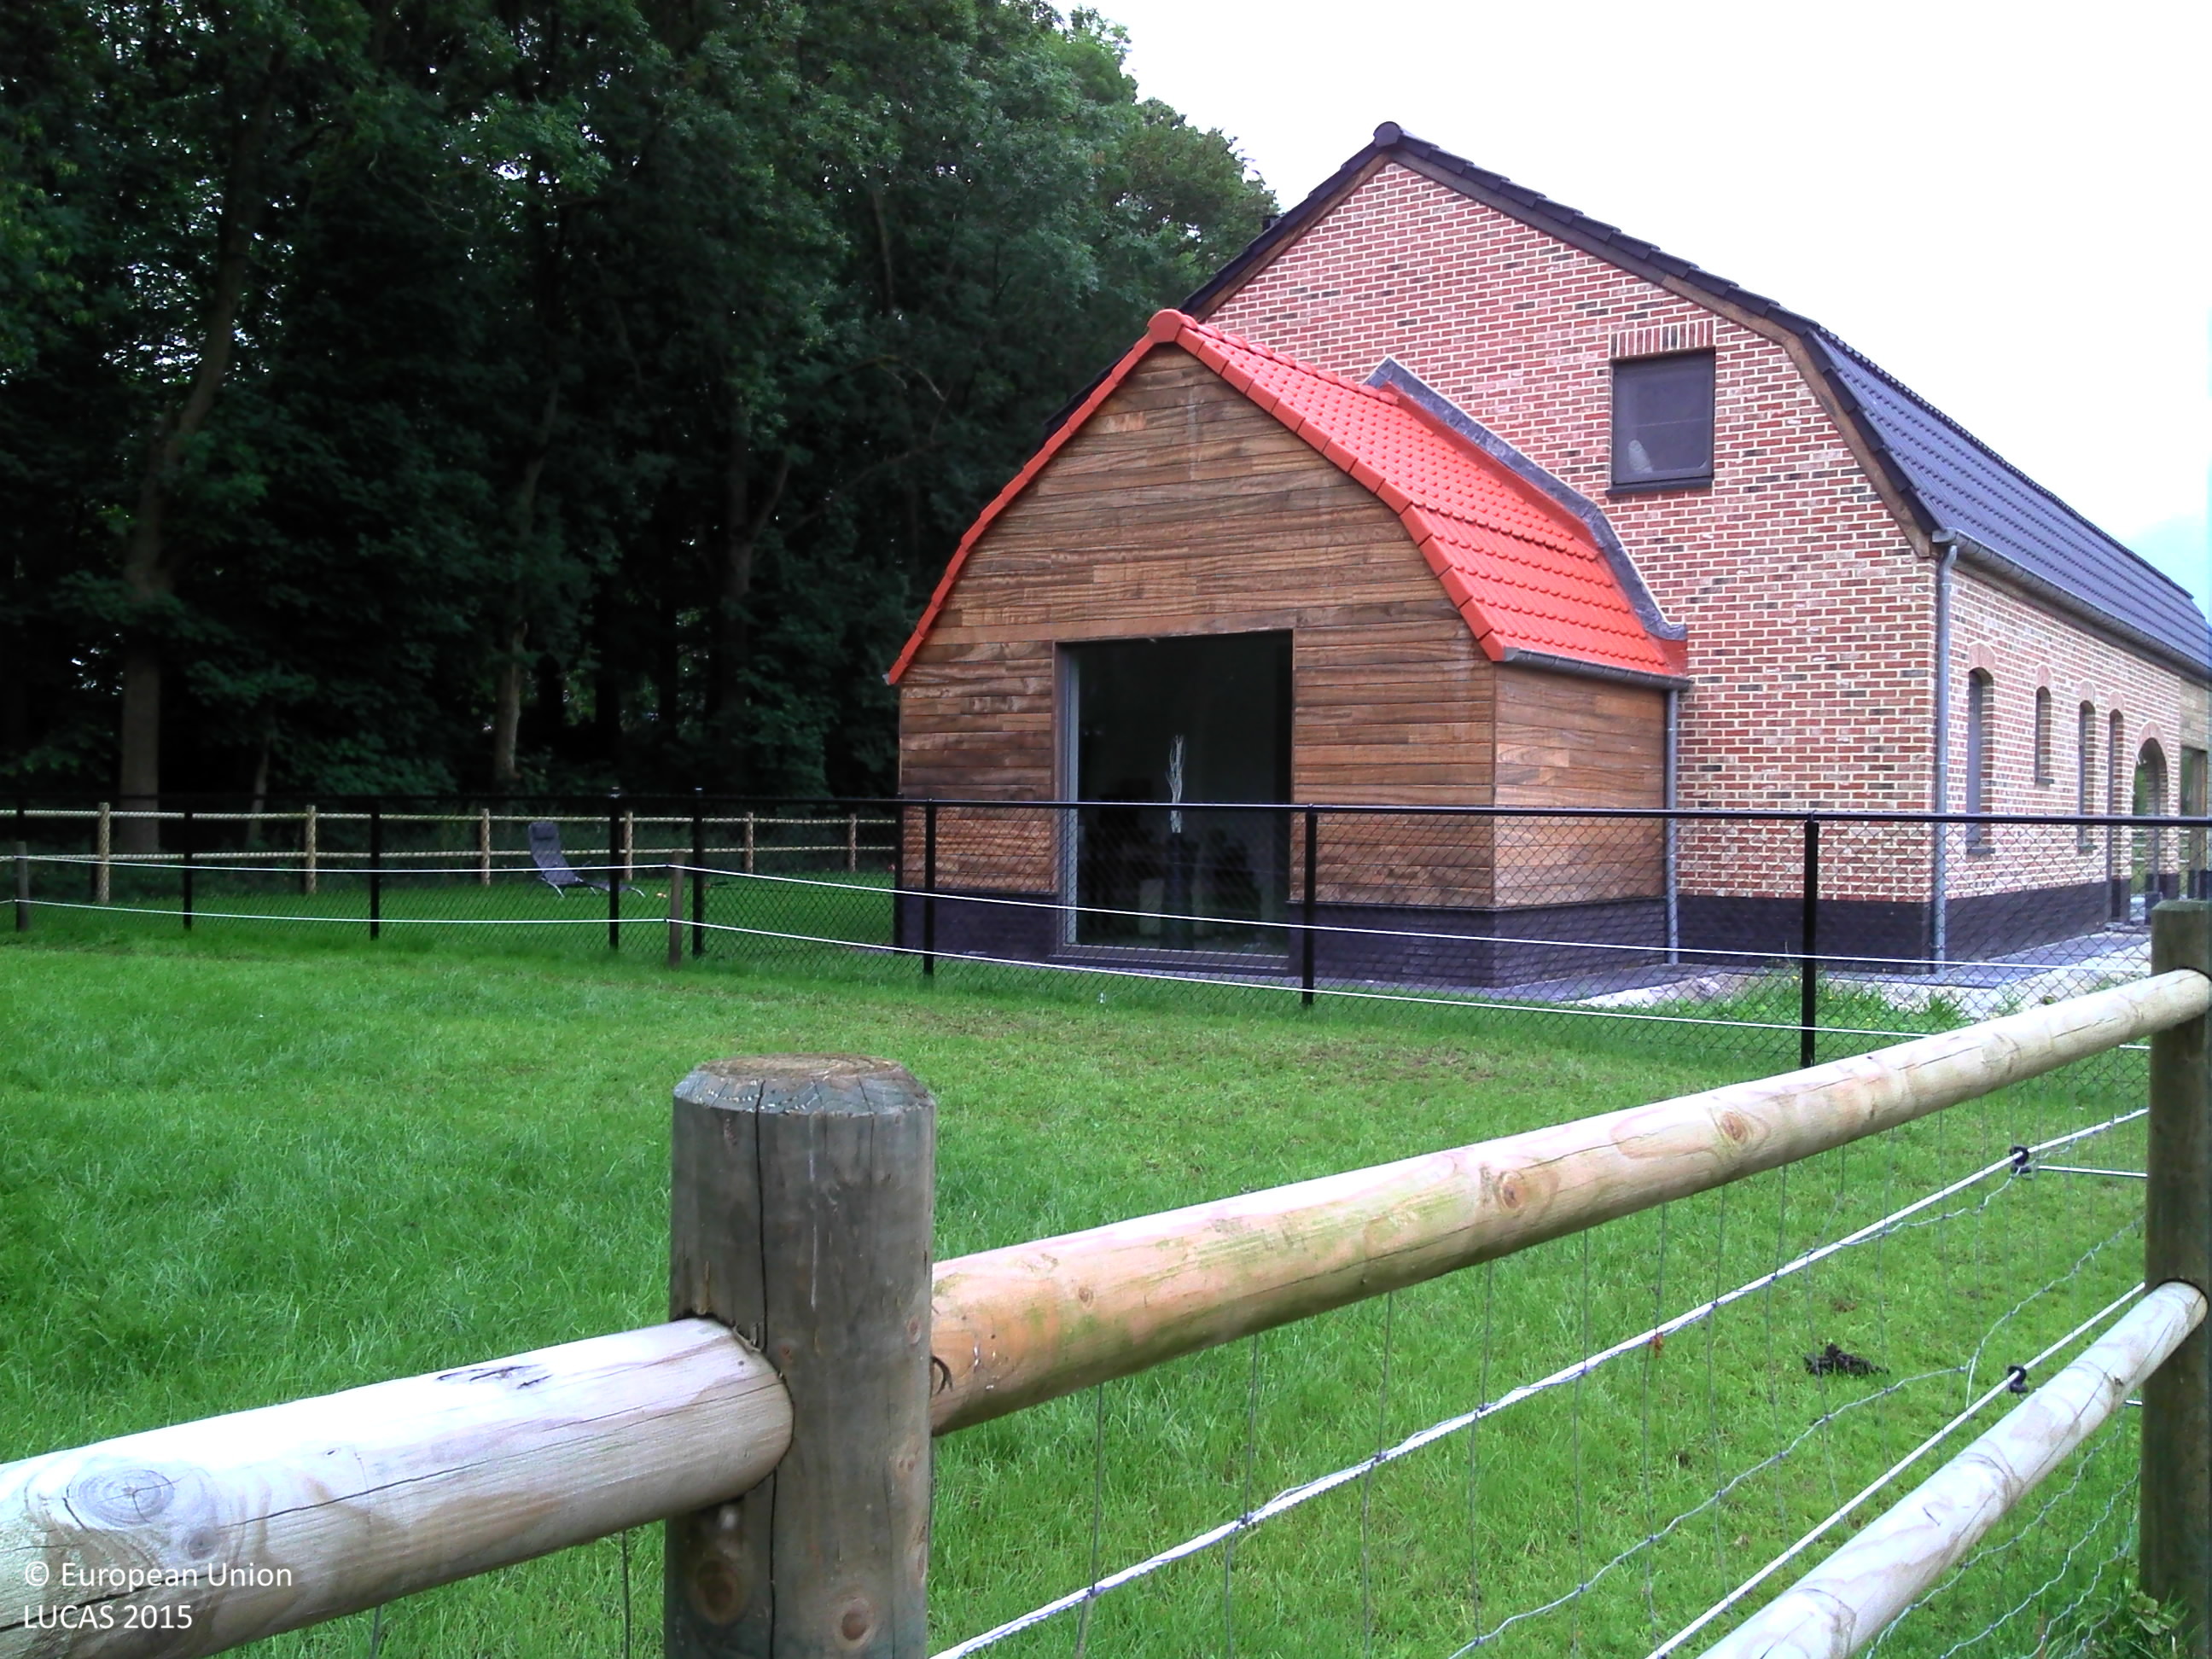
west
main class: Woodland
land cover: Broadleaved woodland
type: mesophytic deciduous forest
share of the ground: > 75 %
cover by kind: broadleaved forest trees 90 %, herbaceous plants 10 %
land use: Semi-natural and natural areas not in use
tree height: > 5 m
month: July
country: BE
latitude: 51.2295
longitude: 5.4871
